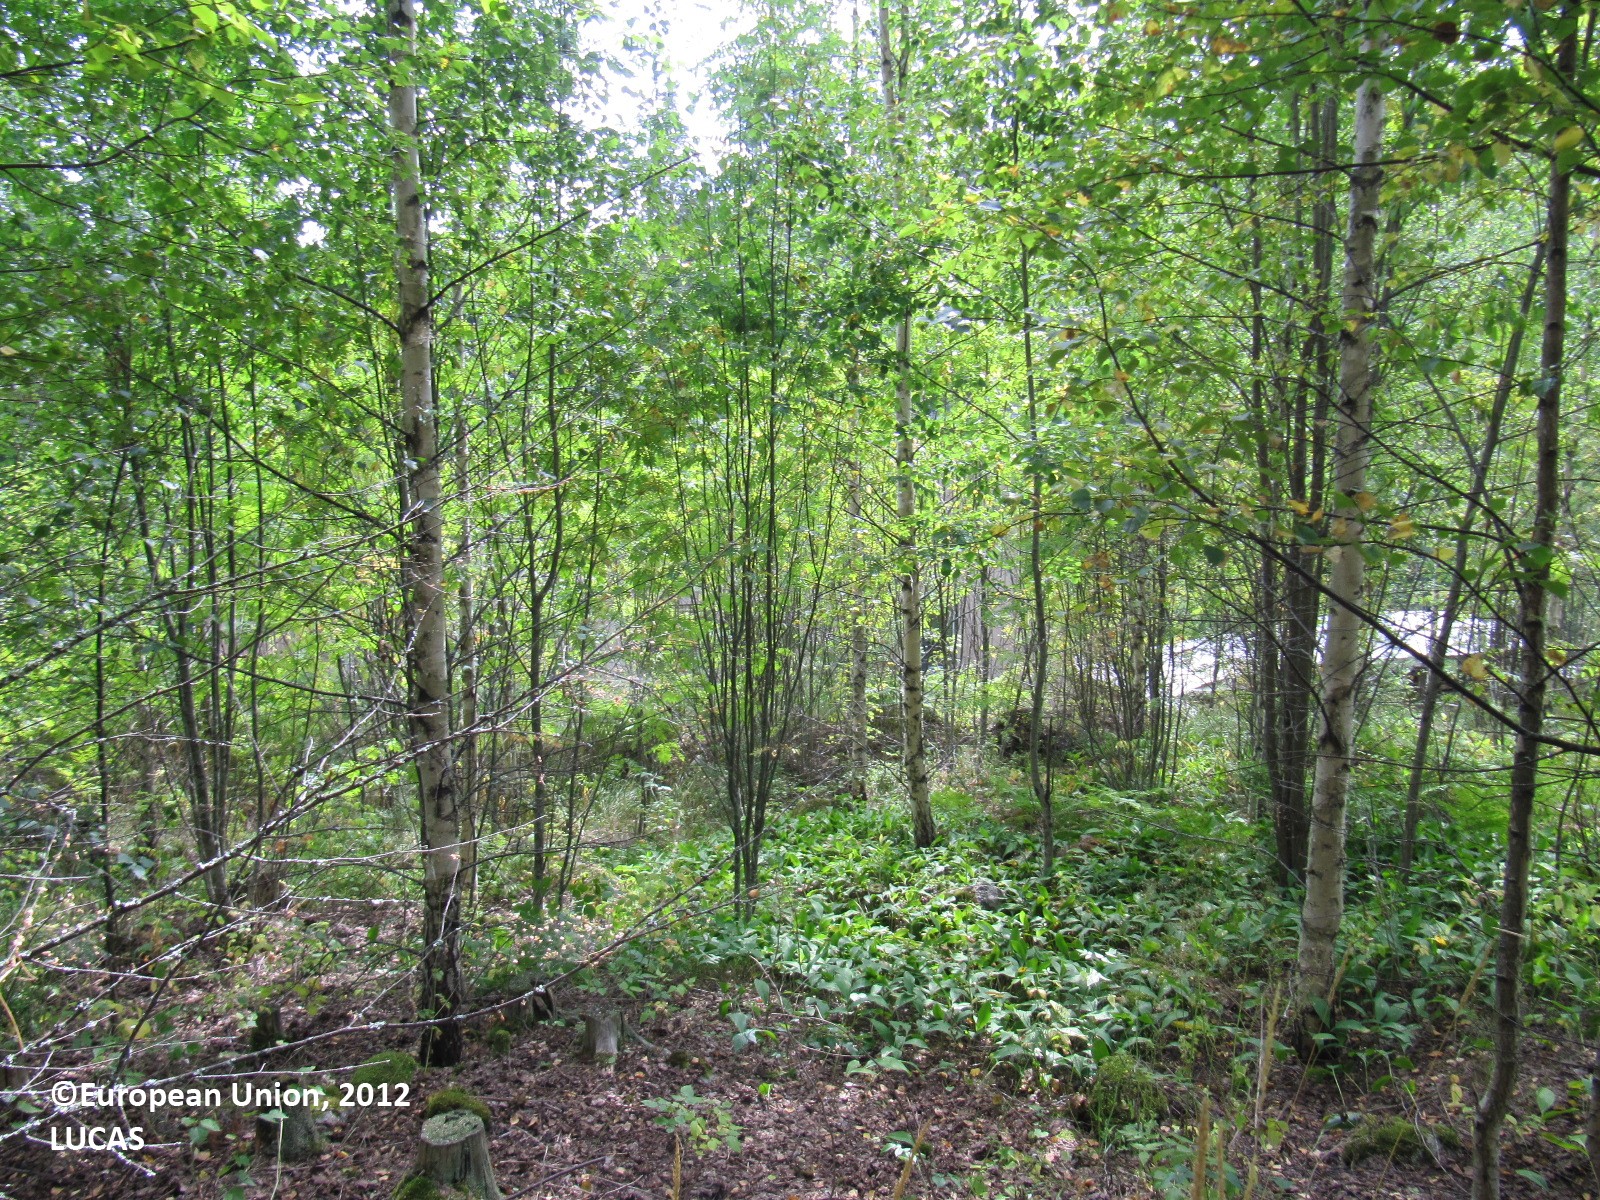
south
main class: Woodland
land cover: Broadleaved woodland
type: boreal forest
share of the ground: > 75 %
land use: Forestry
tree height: > 5 m
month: August
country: FI
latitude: 60.4306
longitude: 24.3649
